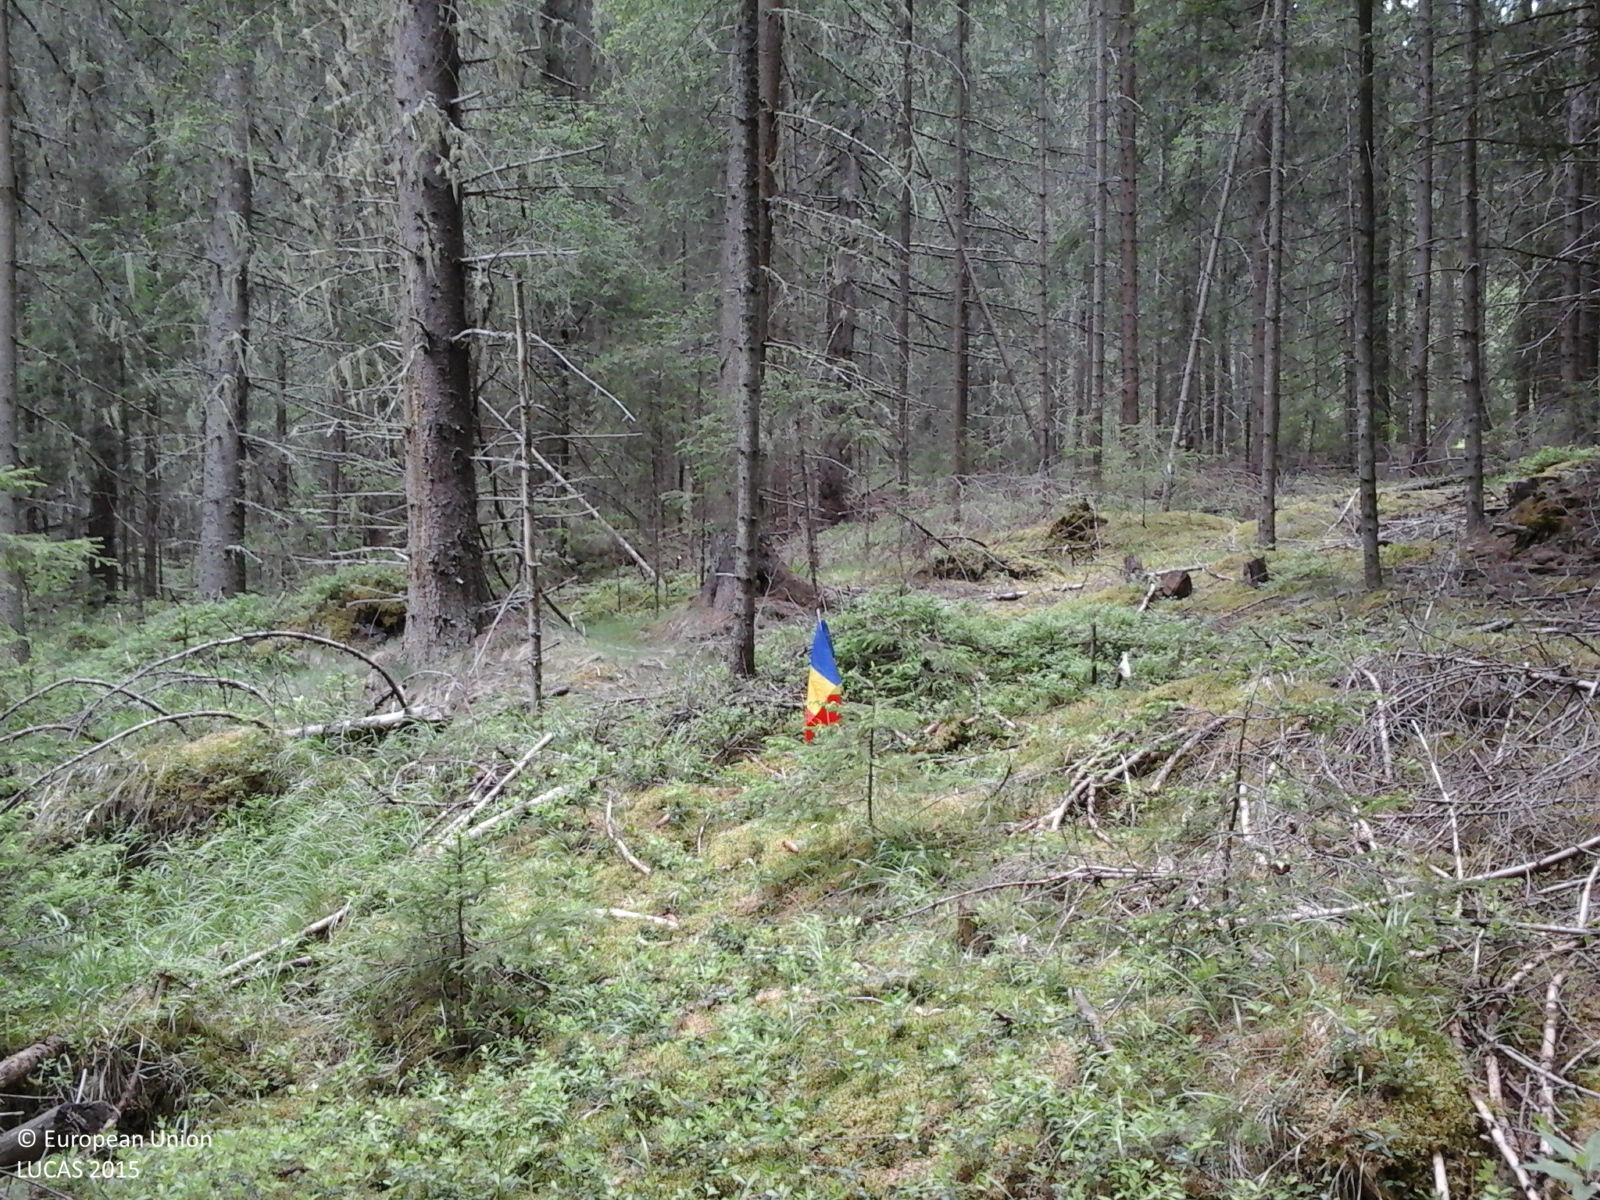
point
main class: Woodland
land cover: Spruce dominated coniferous woodland
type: alpine coniferous forest
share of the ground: > 75 %
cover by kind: coniferous forest trees 100 %
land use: Forestry
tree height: > 5 m
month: June
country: RO
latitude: 47.1480
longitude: 25.4225
